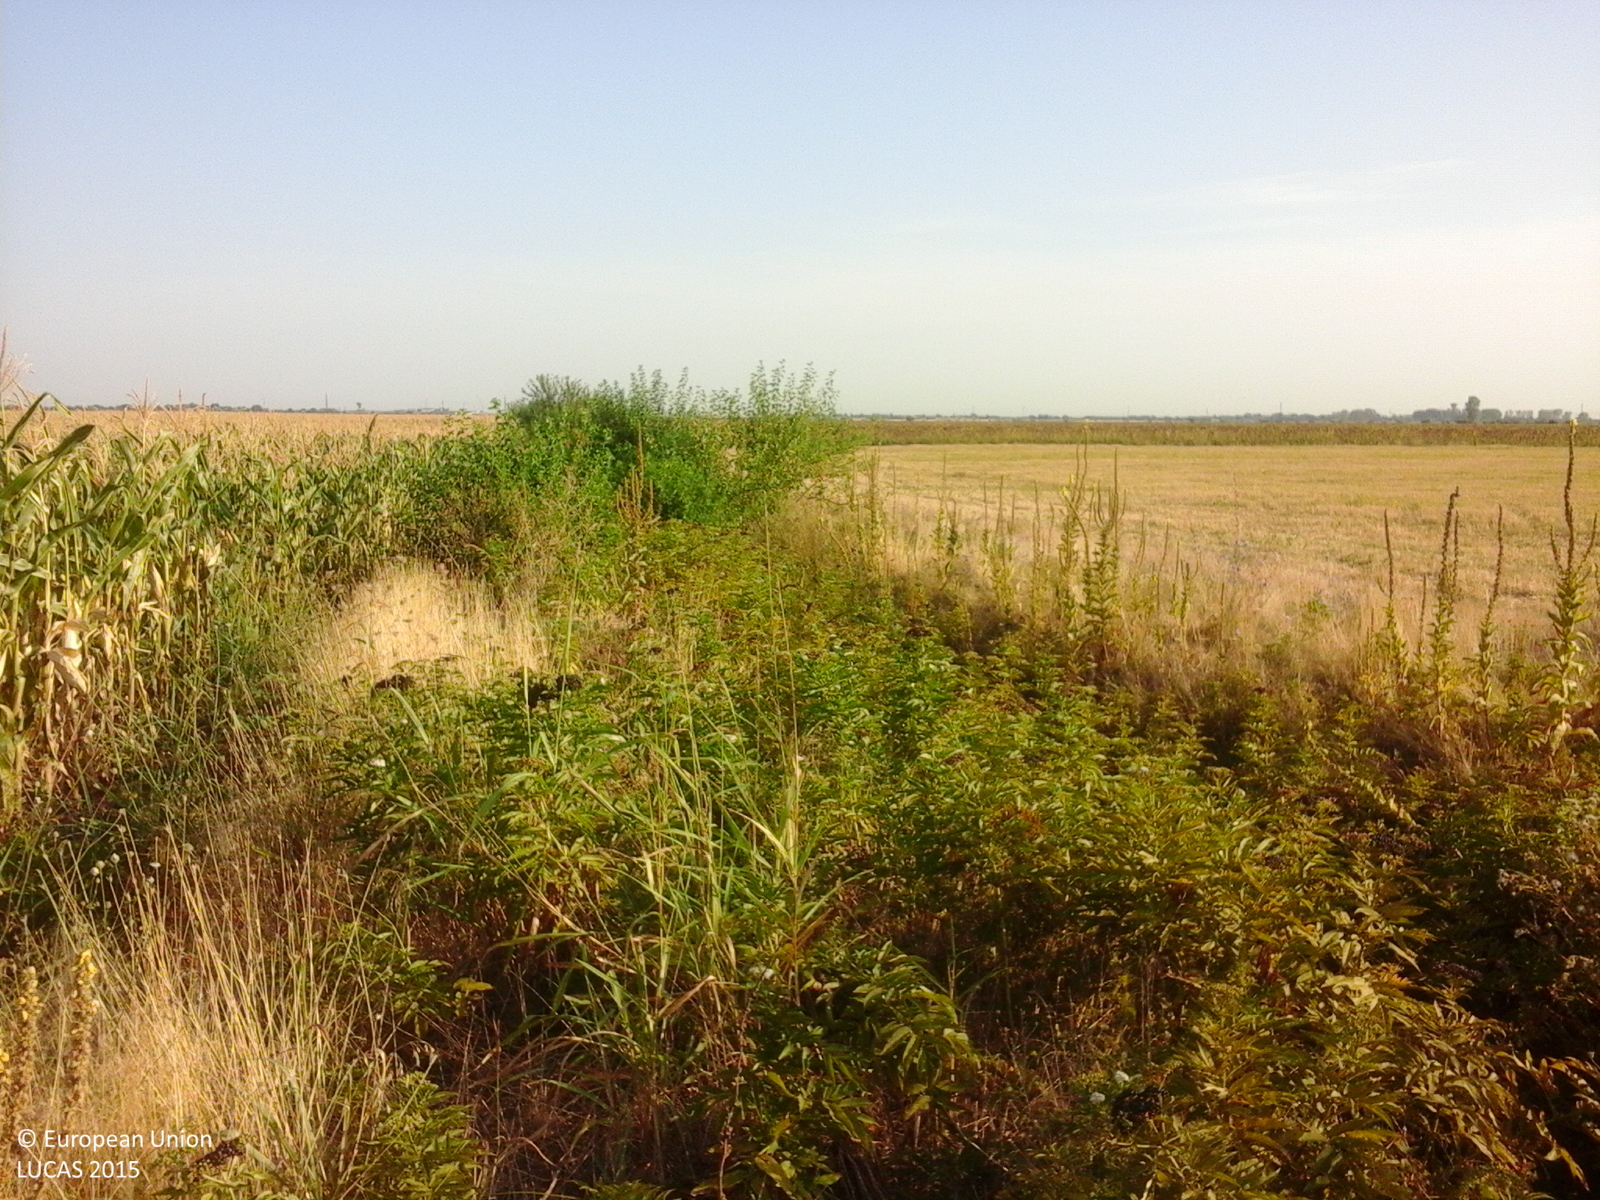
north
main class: Cropland
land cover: Maize
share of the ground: > 75 %
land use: Agriculture (excluding fallow land and kitchen gardens)
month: August
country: RO
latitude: 43.9941
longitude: 23.0732
